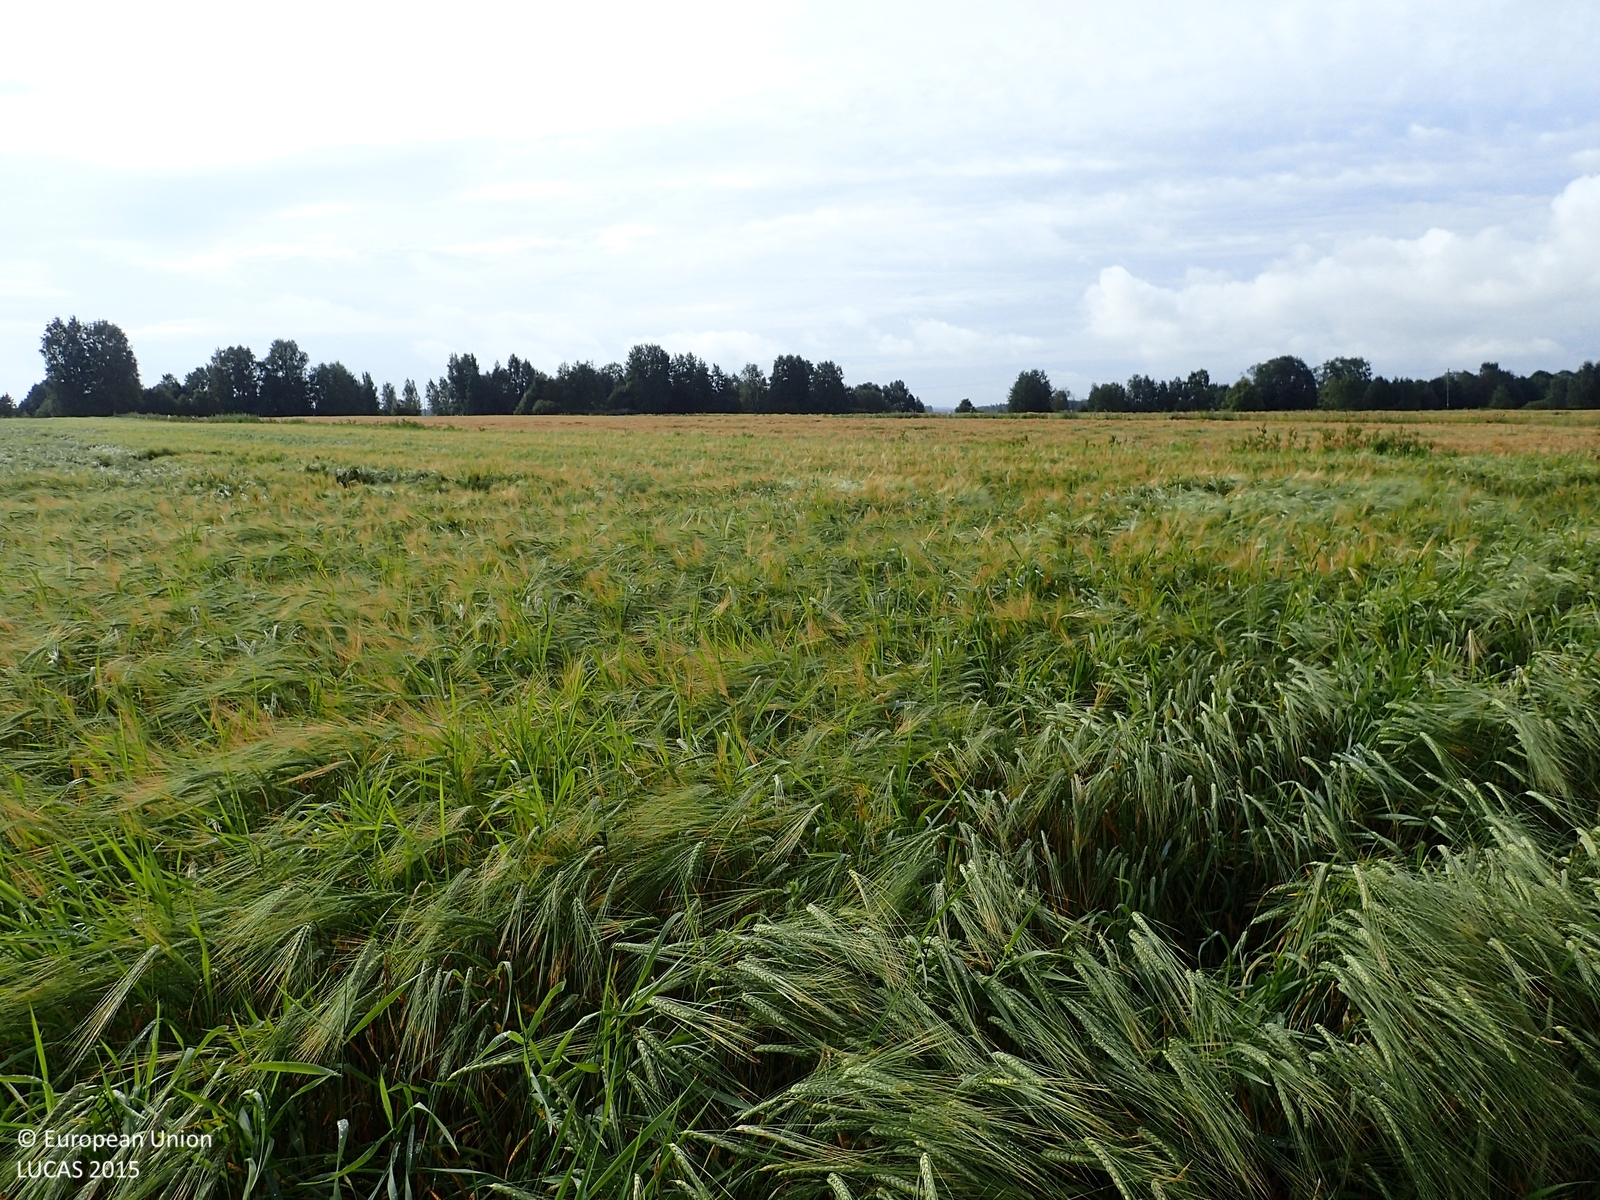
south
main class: Cropland
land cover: Barley
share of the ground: > 75 %
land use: Agriculture (excluding fallow land and kitchen gardens)
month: August
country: FI
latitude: 62.7750
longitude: 22.6142
